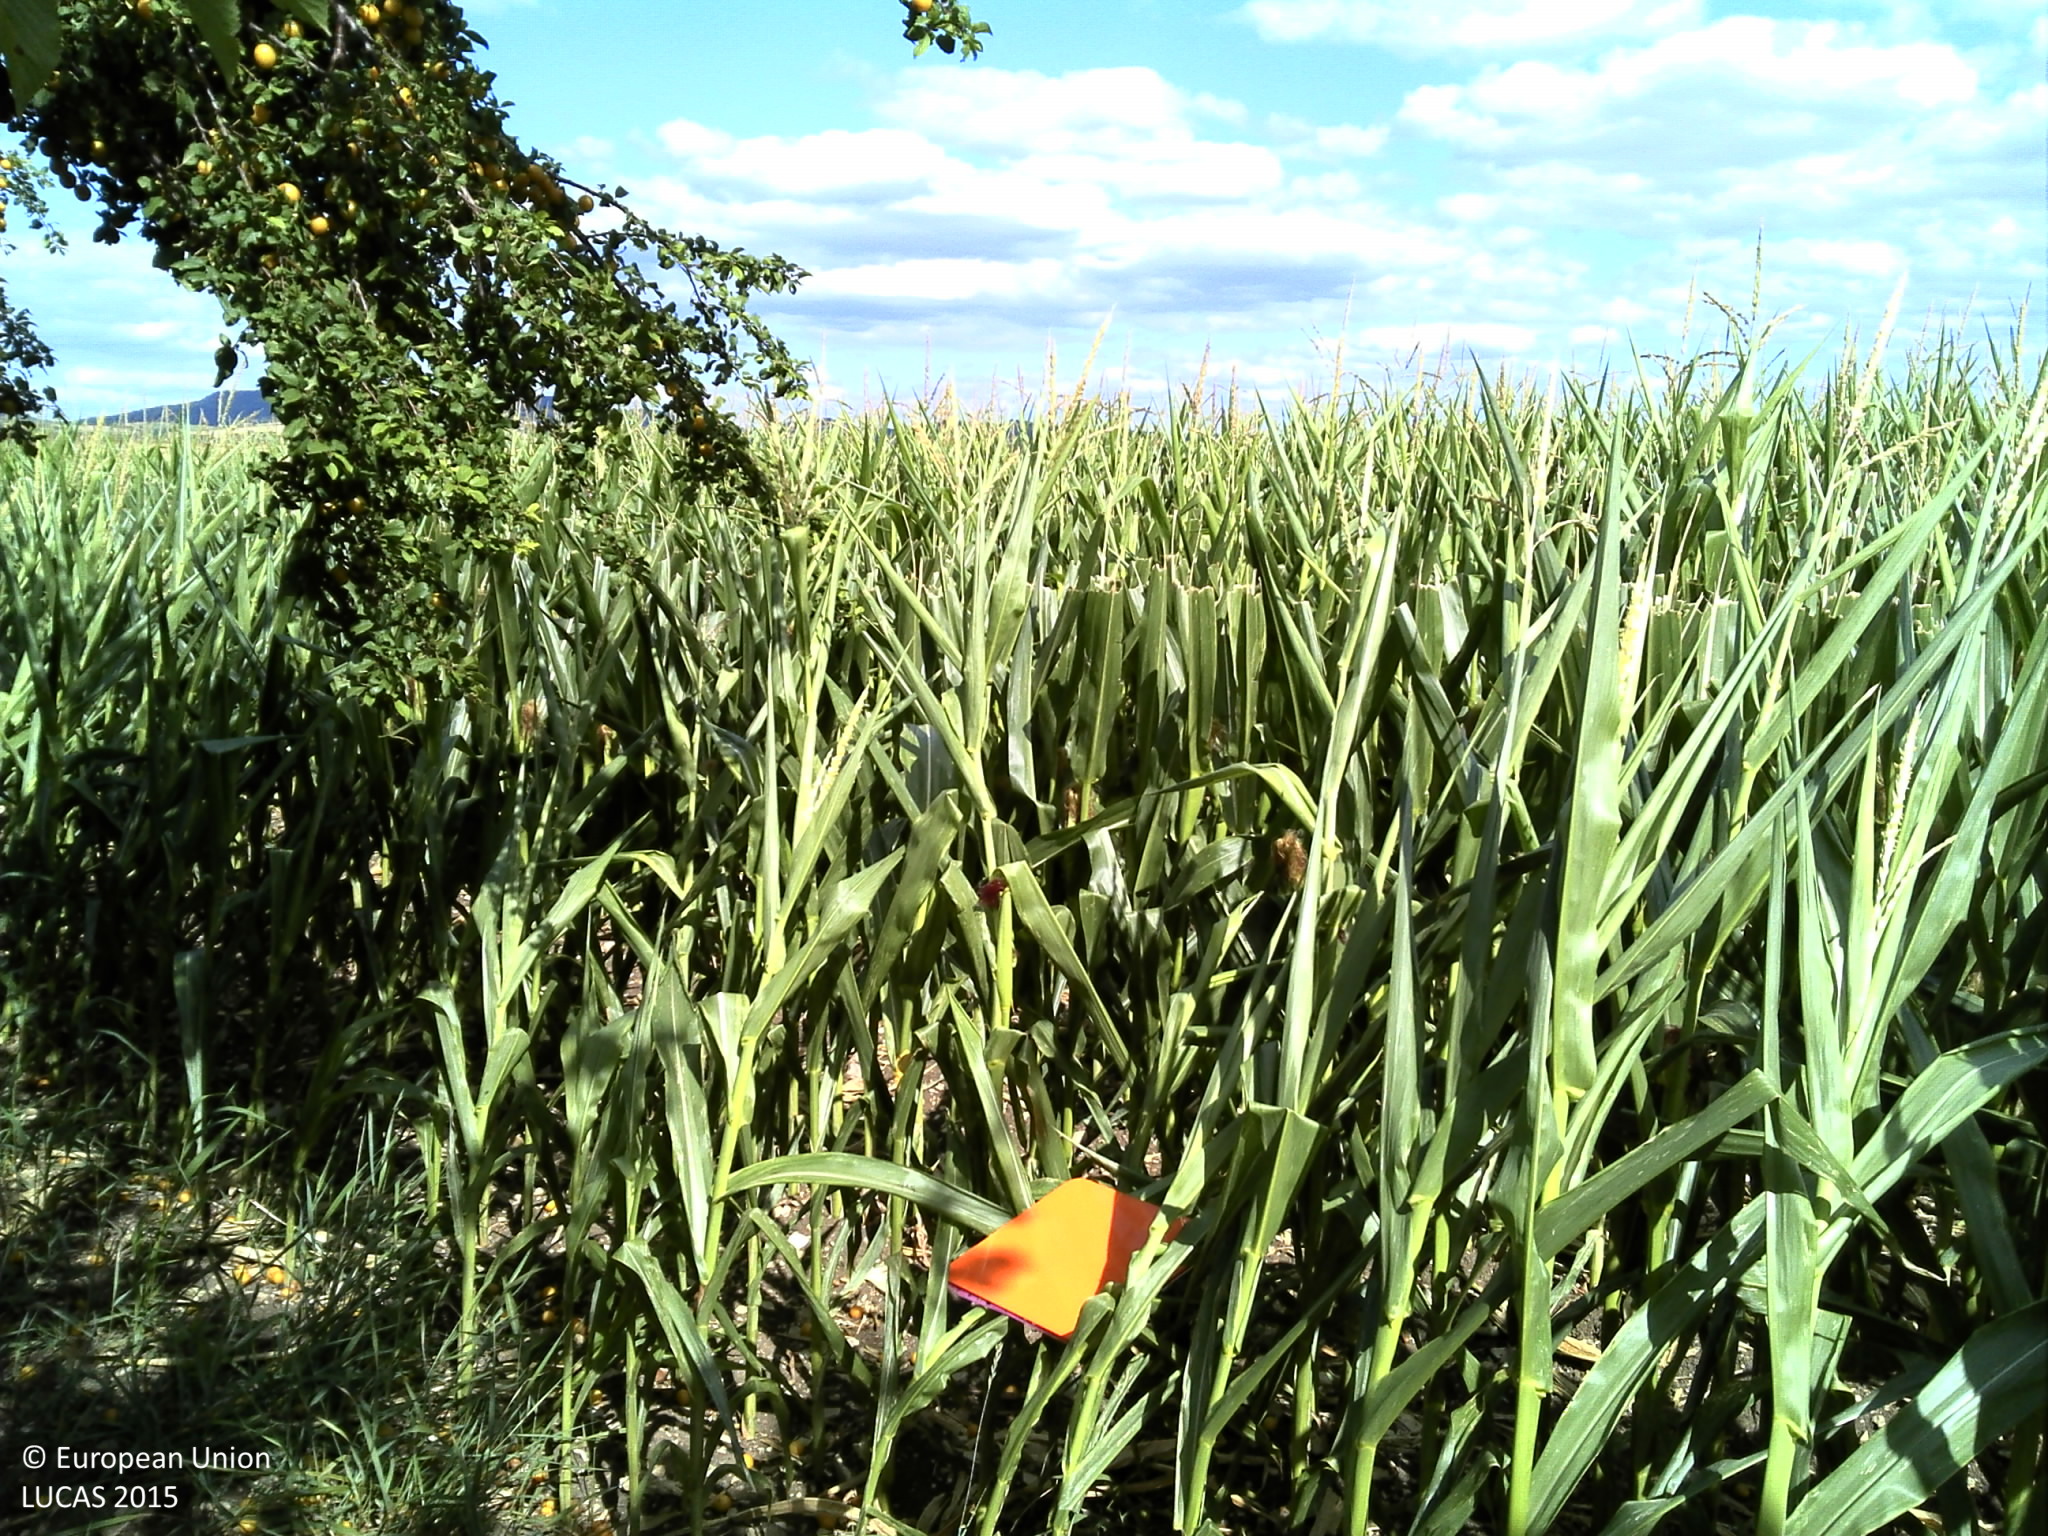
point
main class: Cropland
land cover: Maize
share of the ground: > 75 %
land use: Agriculture (excluding fallow land and kitchen gardens)
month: July
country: FR
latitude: 45.6083
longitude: 3.1662
